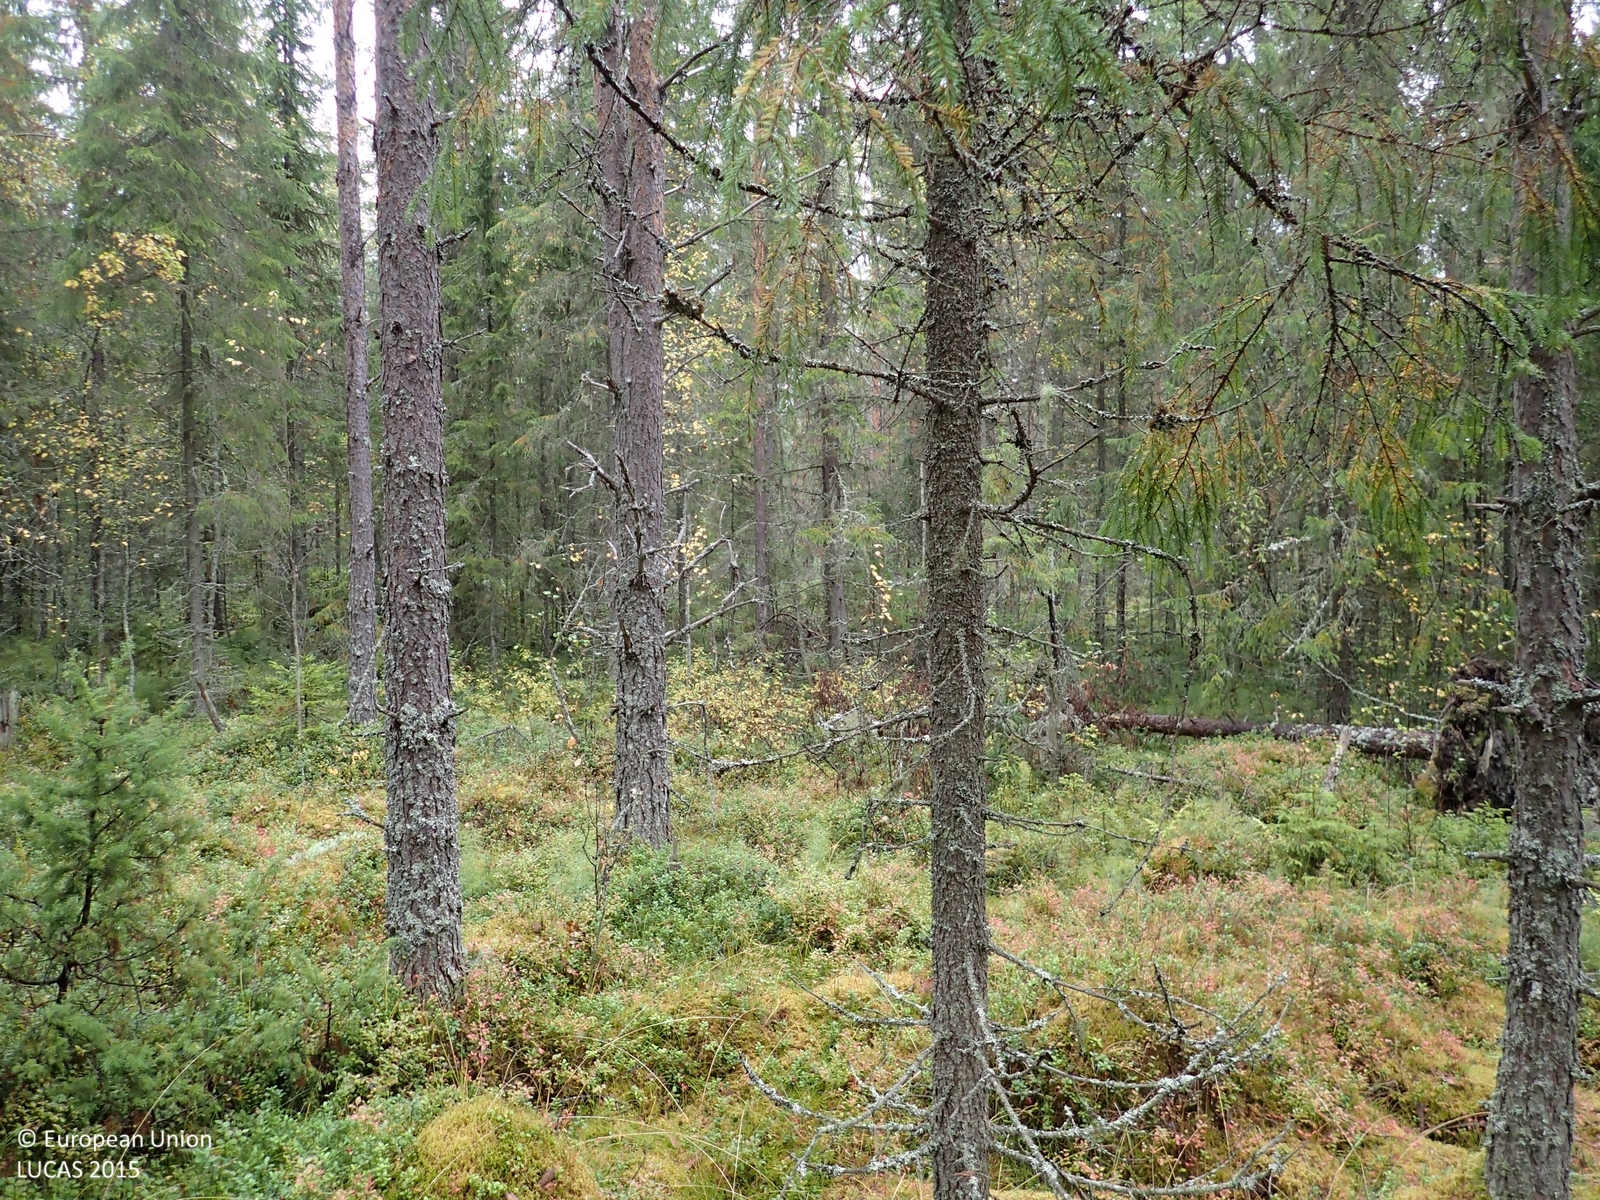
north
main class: Woodland
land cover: Other coniferous woodland
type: boreal forest
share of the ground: > 75 %
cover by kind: coniferous forest trees 70 %, shrubs 20 %, broadleaved forest trees 5 %, lichens and mosses 5 %
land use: Forestry
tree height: > 5 m
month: September
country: FI
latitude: 63.2616
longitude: 25.6670
